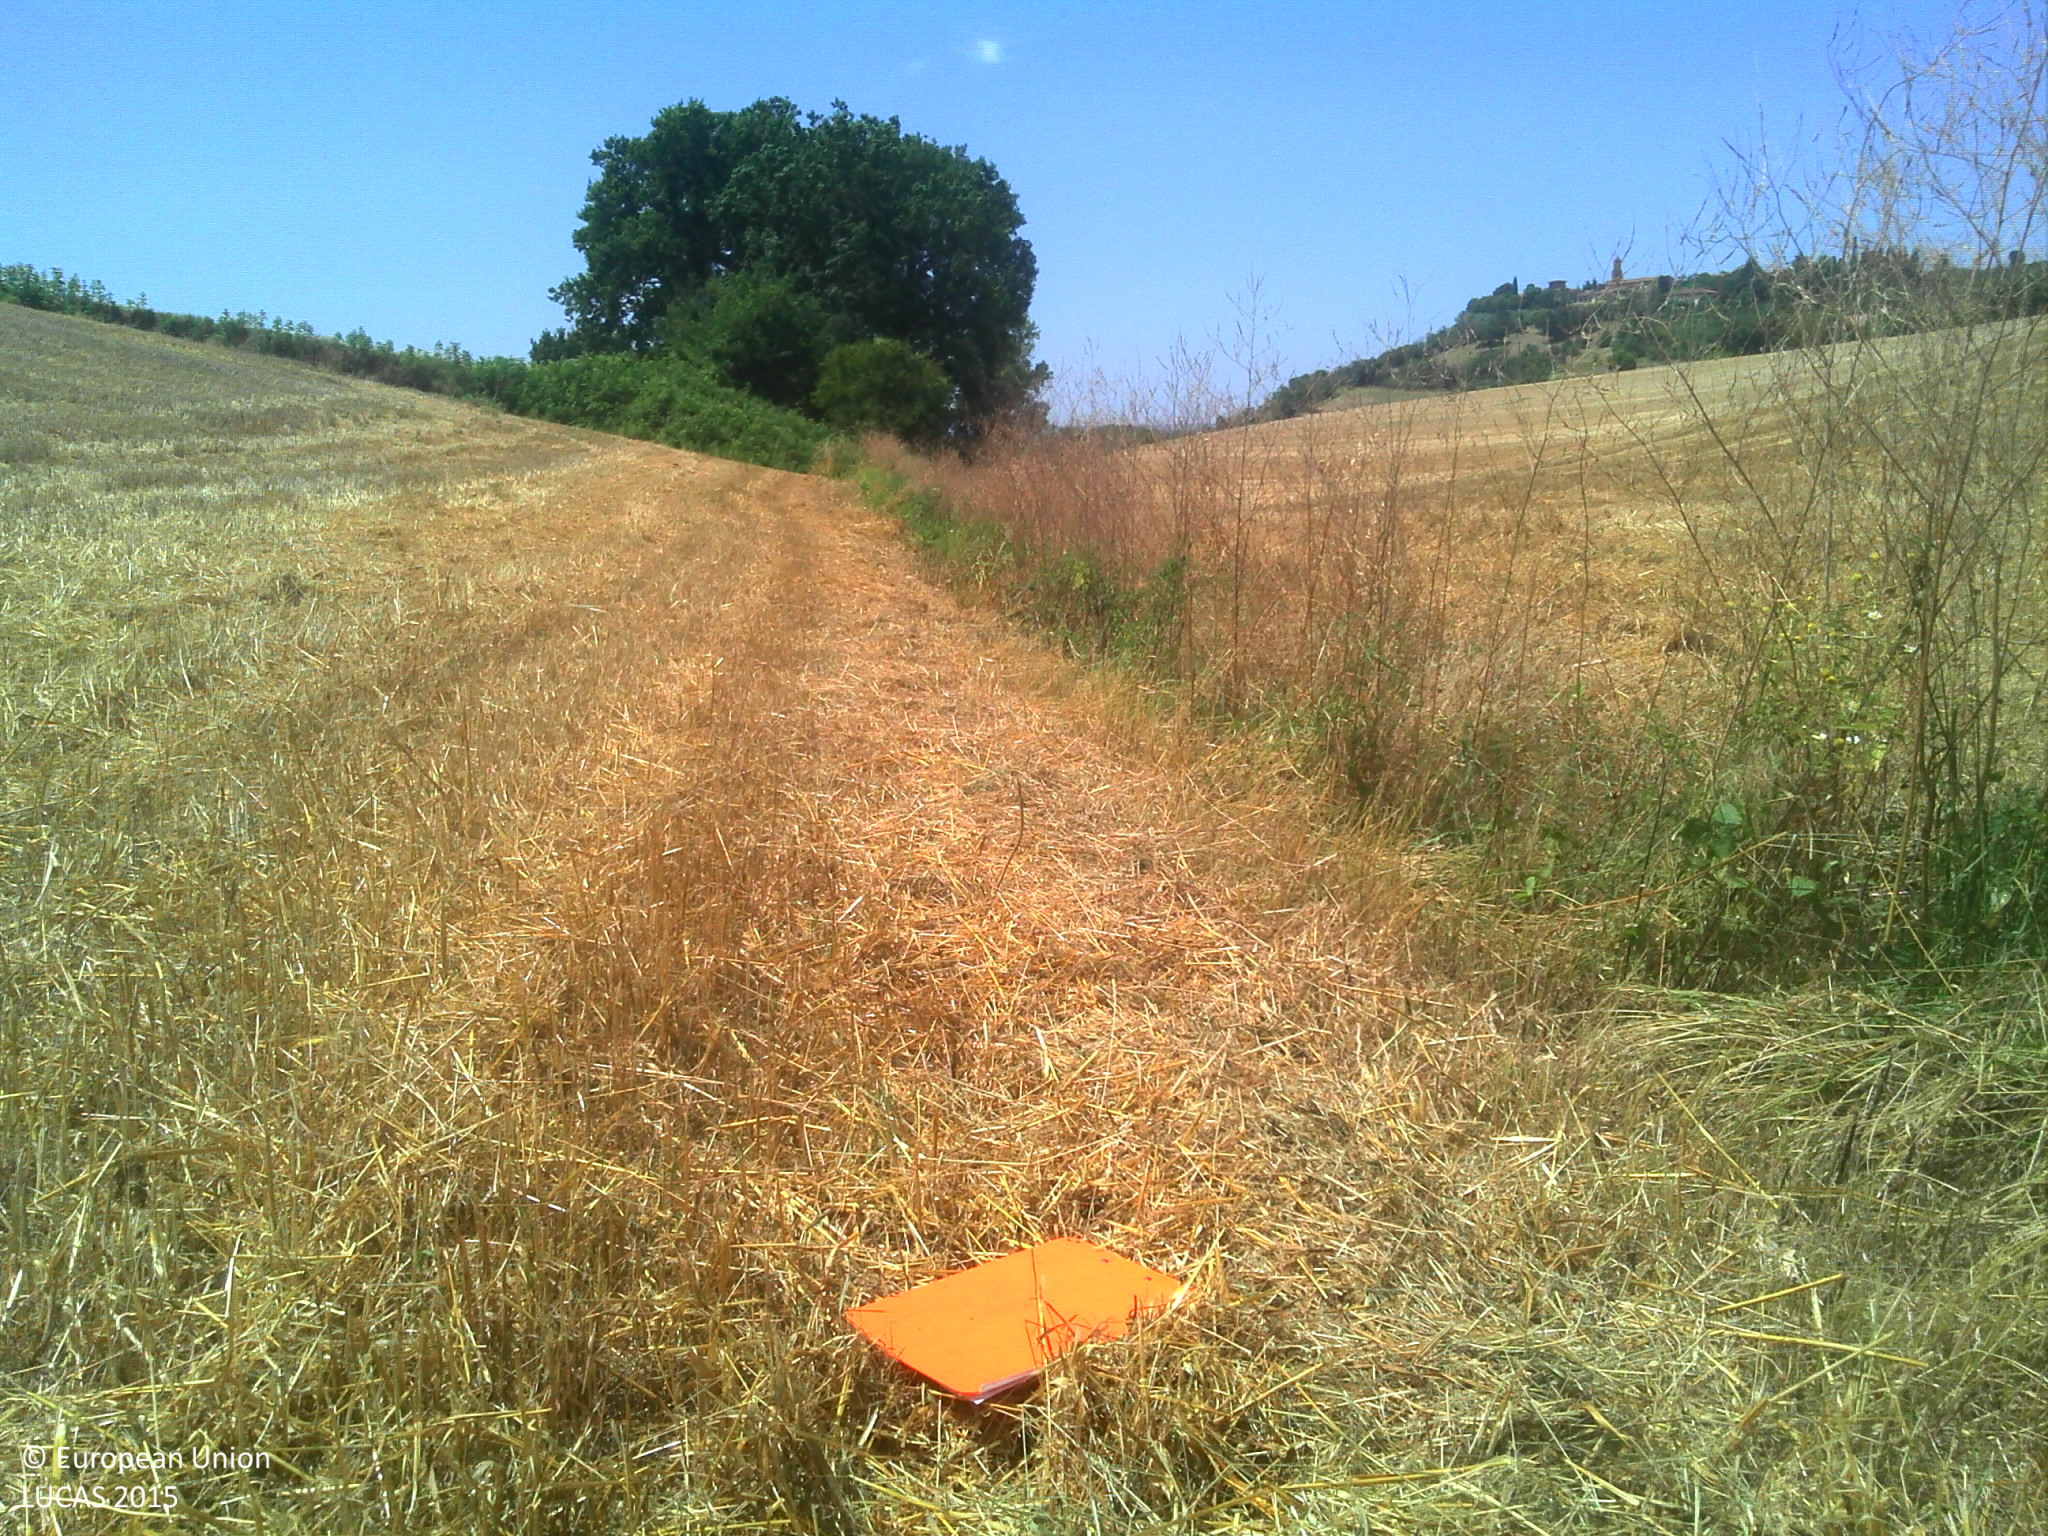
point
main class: Cropland
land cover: Common wheat
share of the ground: > 75 %
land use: Agriculture (excluding fallow land and kitchen gardens)
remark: Harvested field
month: July
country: FR
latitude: 43.4523
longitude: 1.4395
